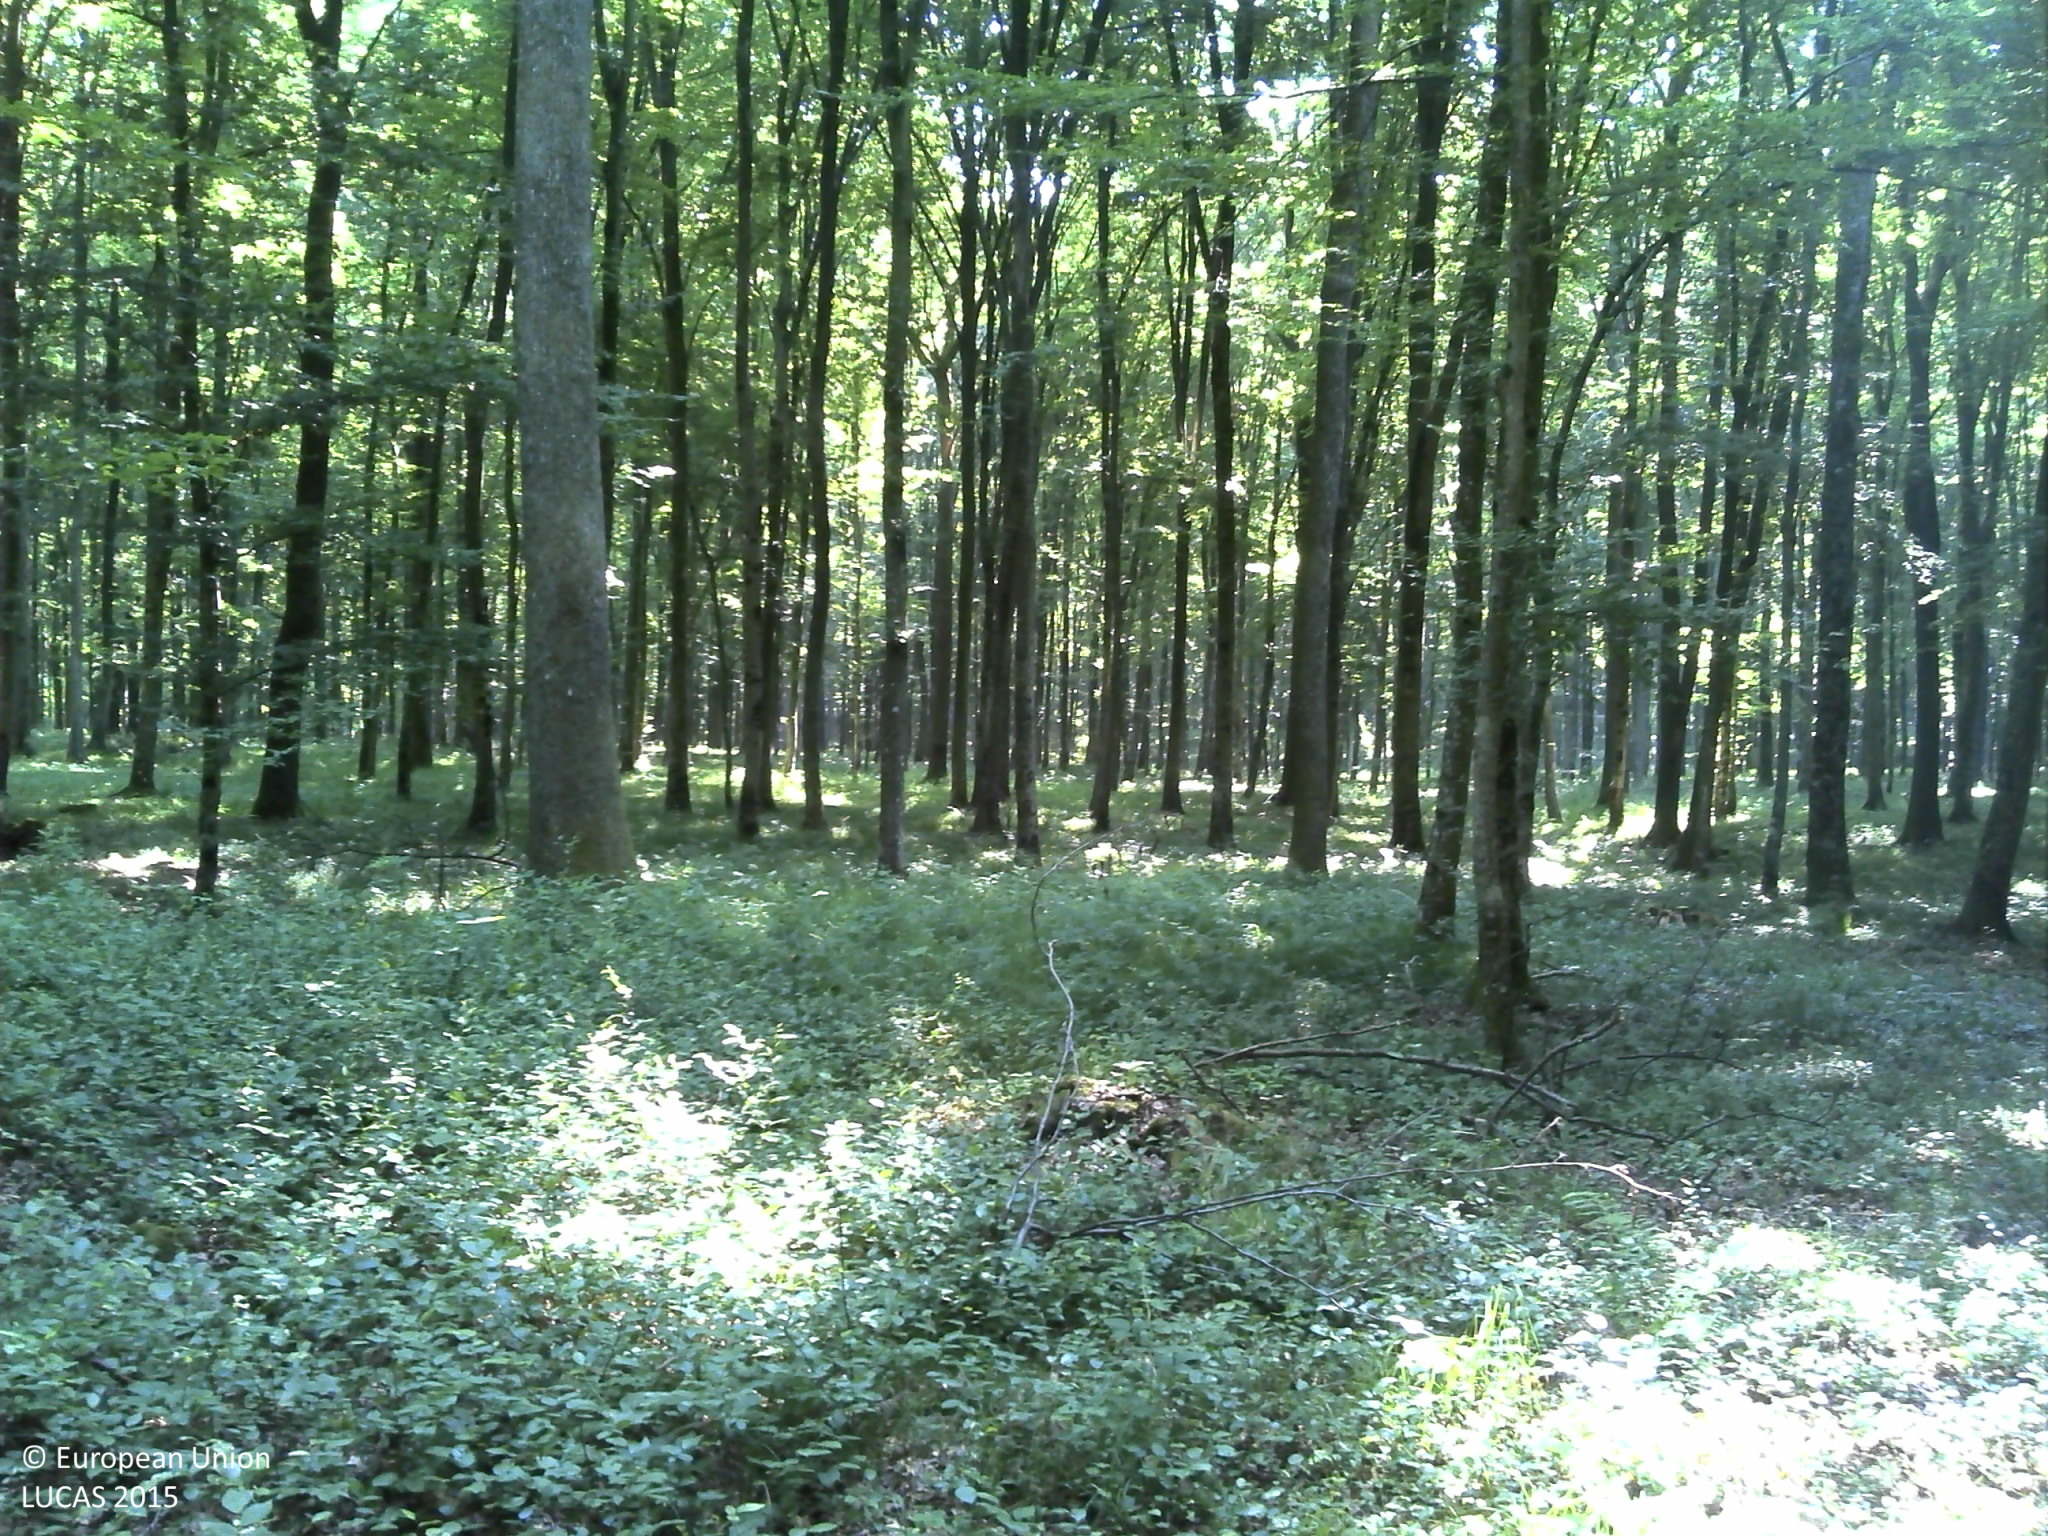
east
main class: Woodland
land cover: Broadleaved woodland
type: mesophytic deciduous forest
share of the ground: > 75 %
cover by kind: broadleaved forest trees 90 %, shrubs 5 %, herbaceous plants 5 %
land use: Forestry
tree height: > 5 m
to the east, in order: Broadleaved woodland
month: July
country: HR
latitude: 45.7908
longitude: 16.5212
